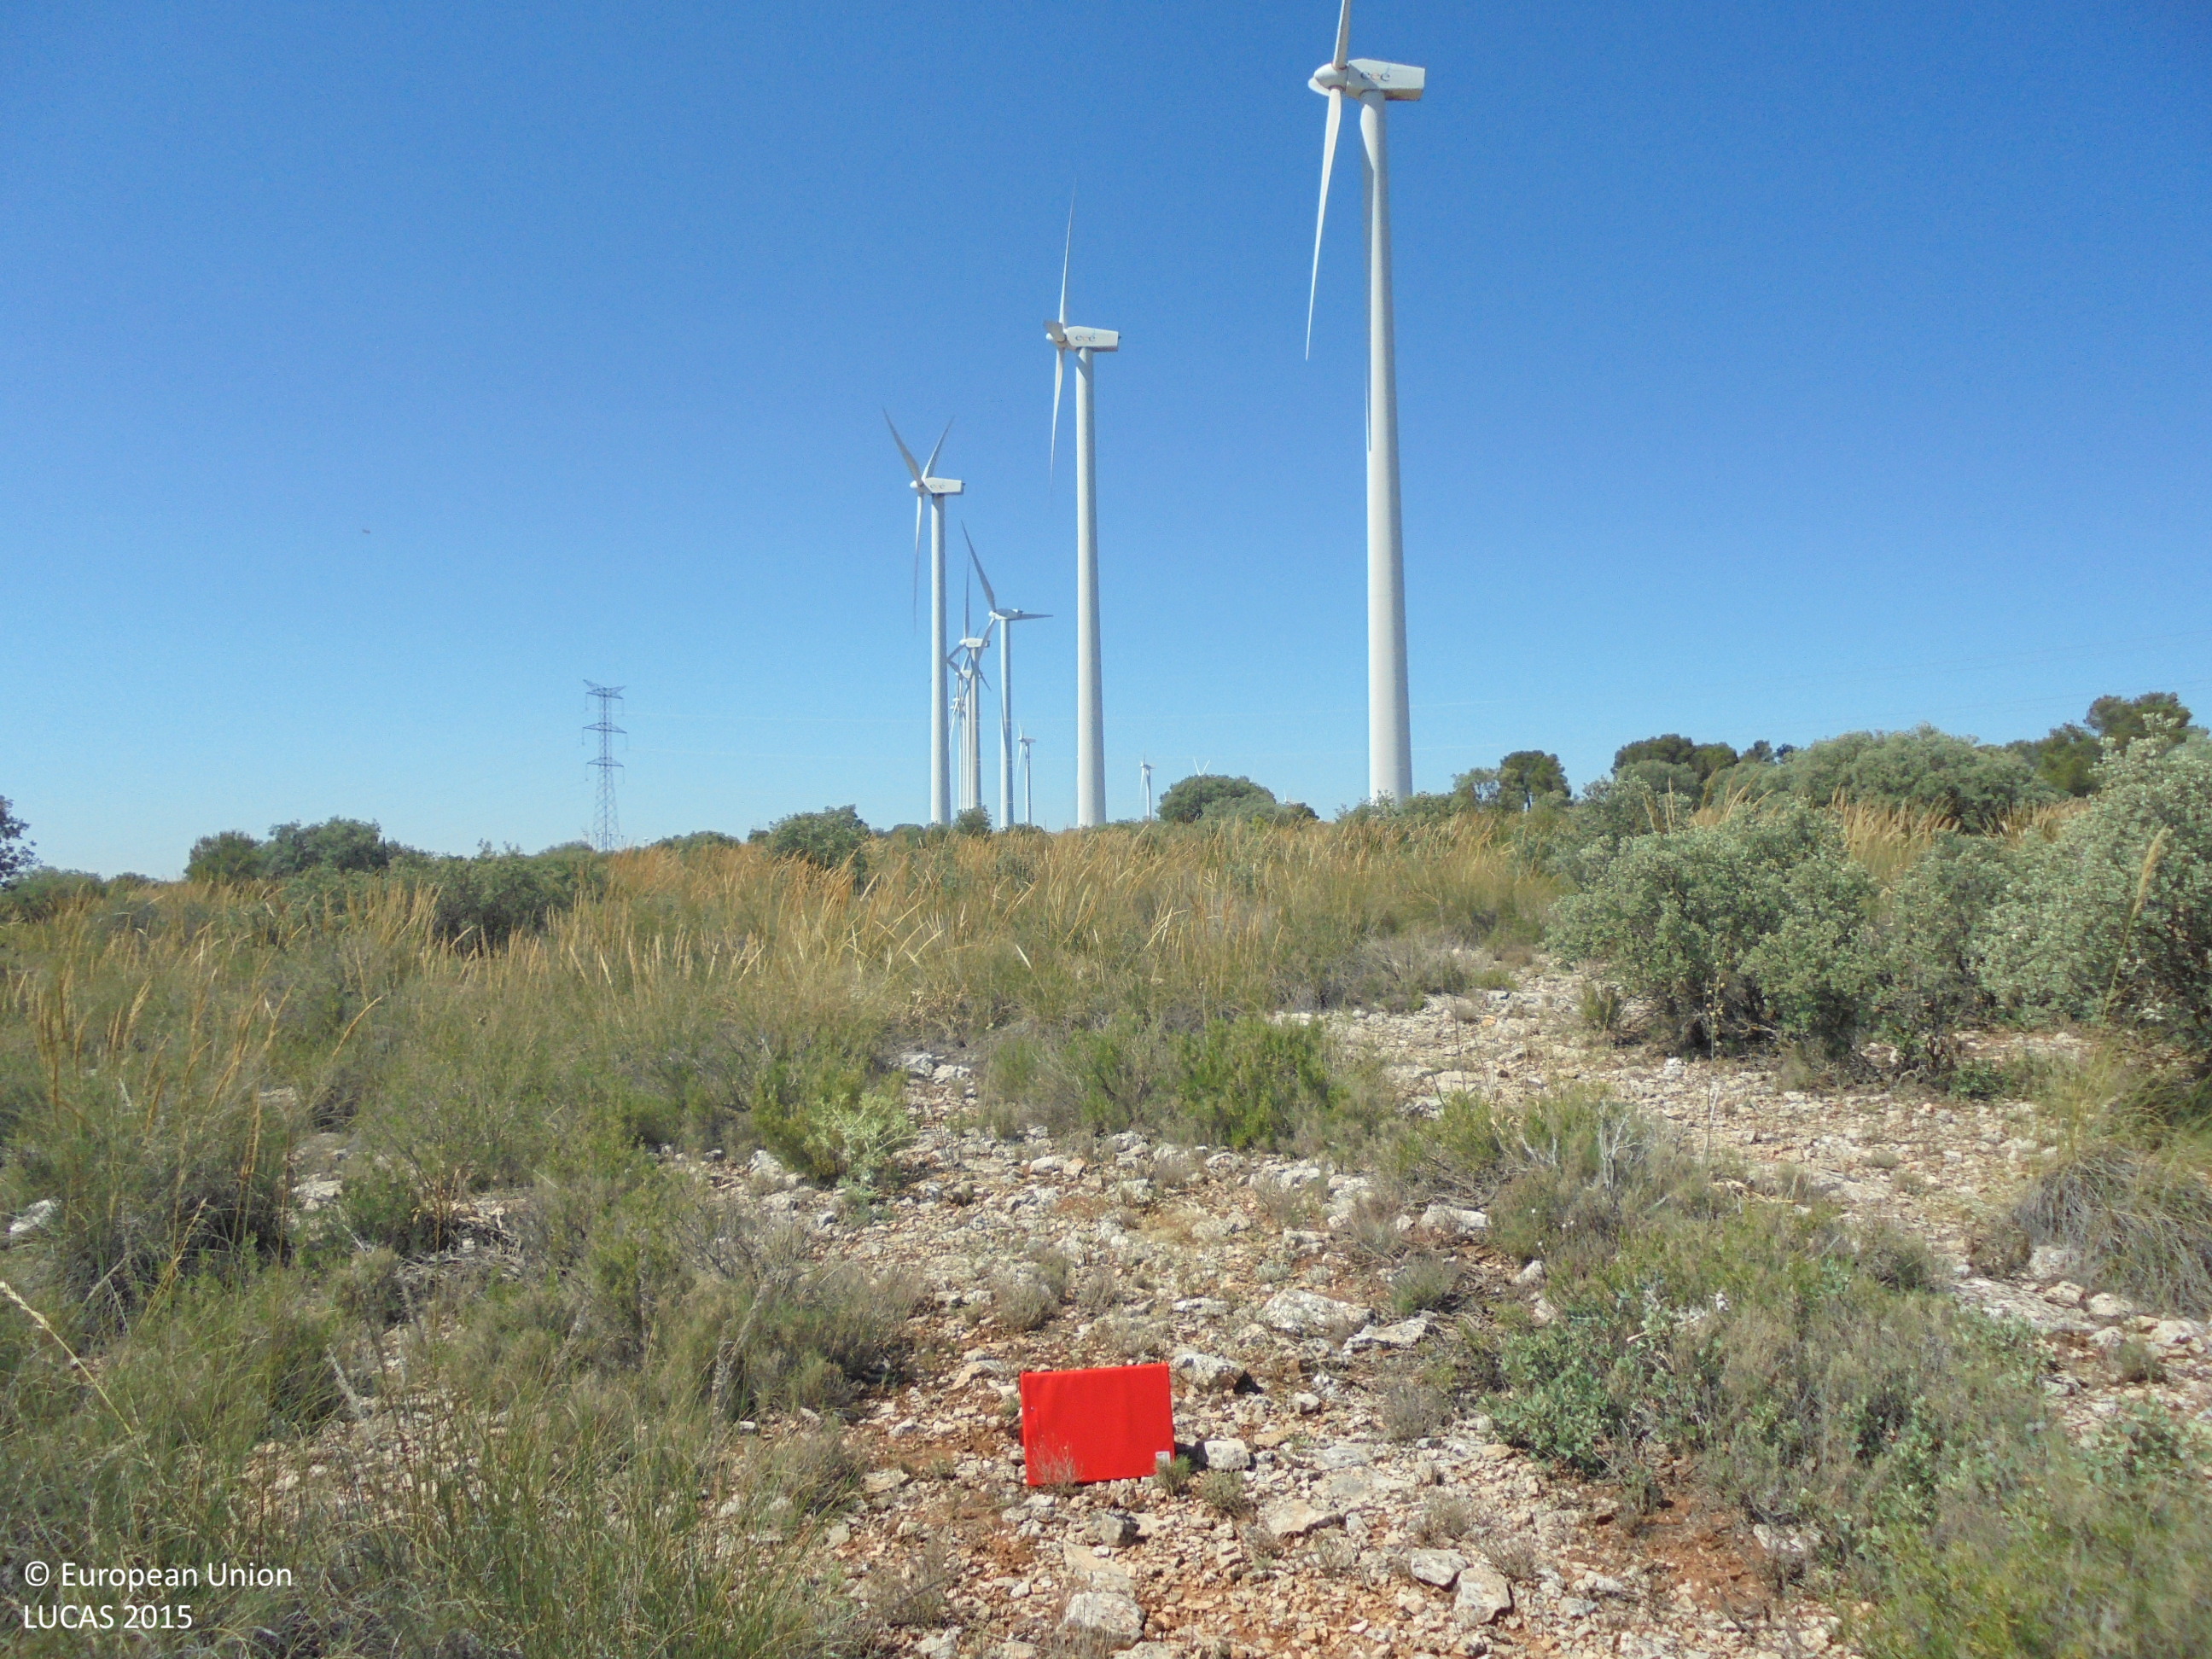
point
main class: Shrubland
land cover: Shrubland without tree cover
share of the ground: 50 - 75 %
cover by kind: shrubs 65 %, unconsolidated bare surface 25 %, consolidated bare surface 10 %
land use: Semi-natural and natural areas not in use
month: June
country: ES
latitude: 38.8378
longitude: -1.6674
